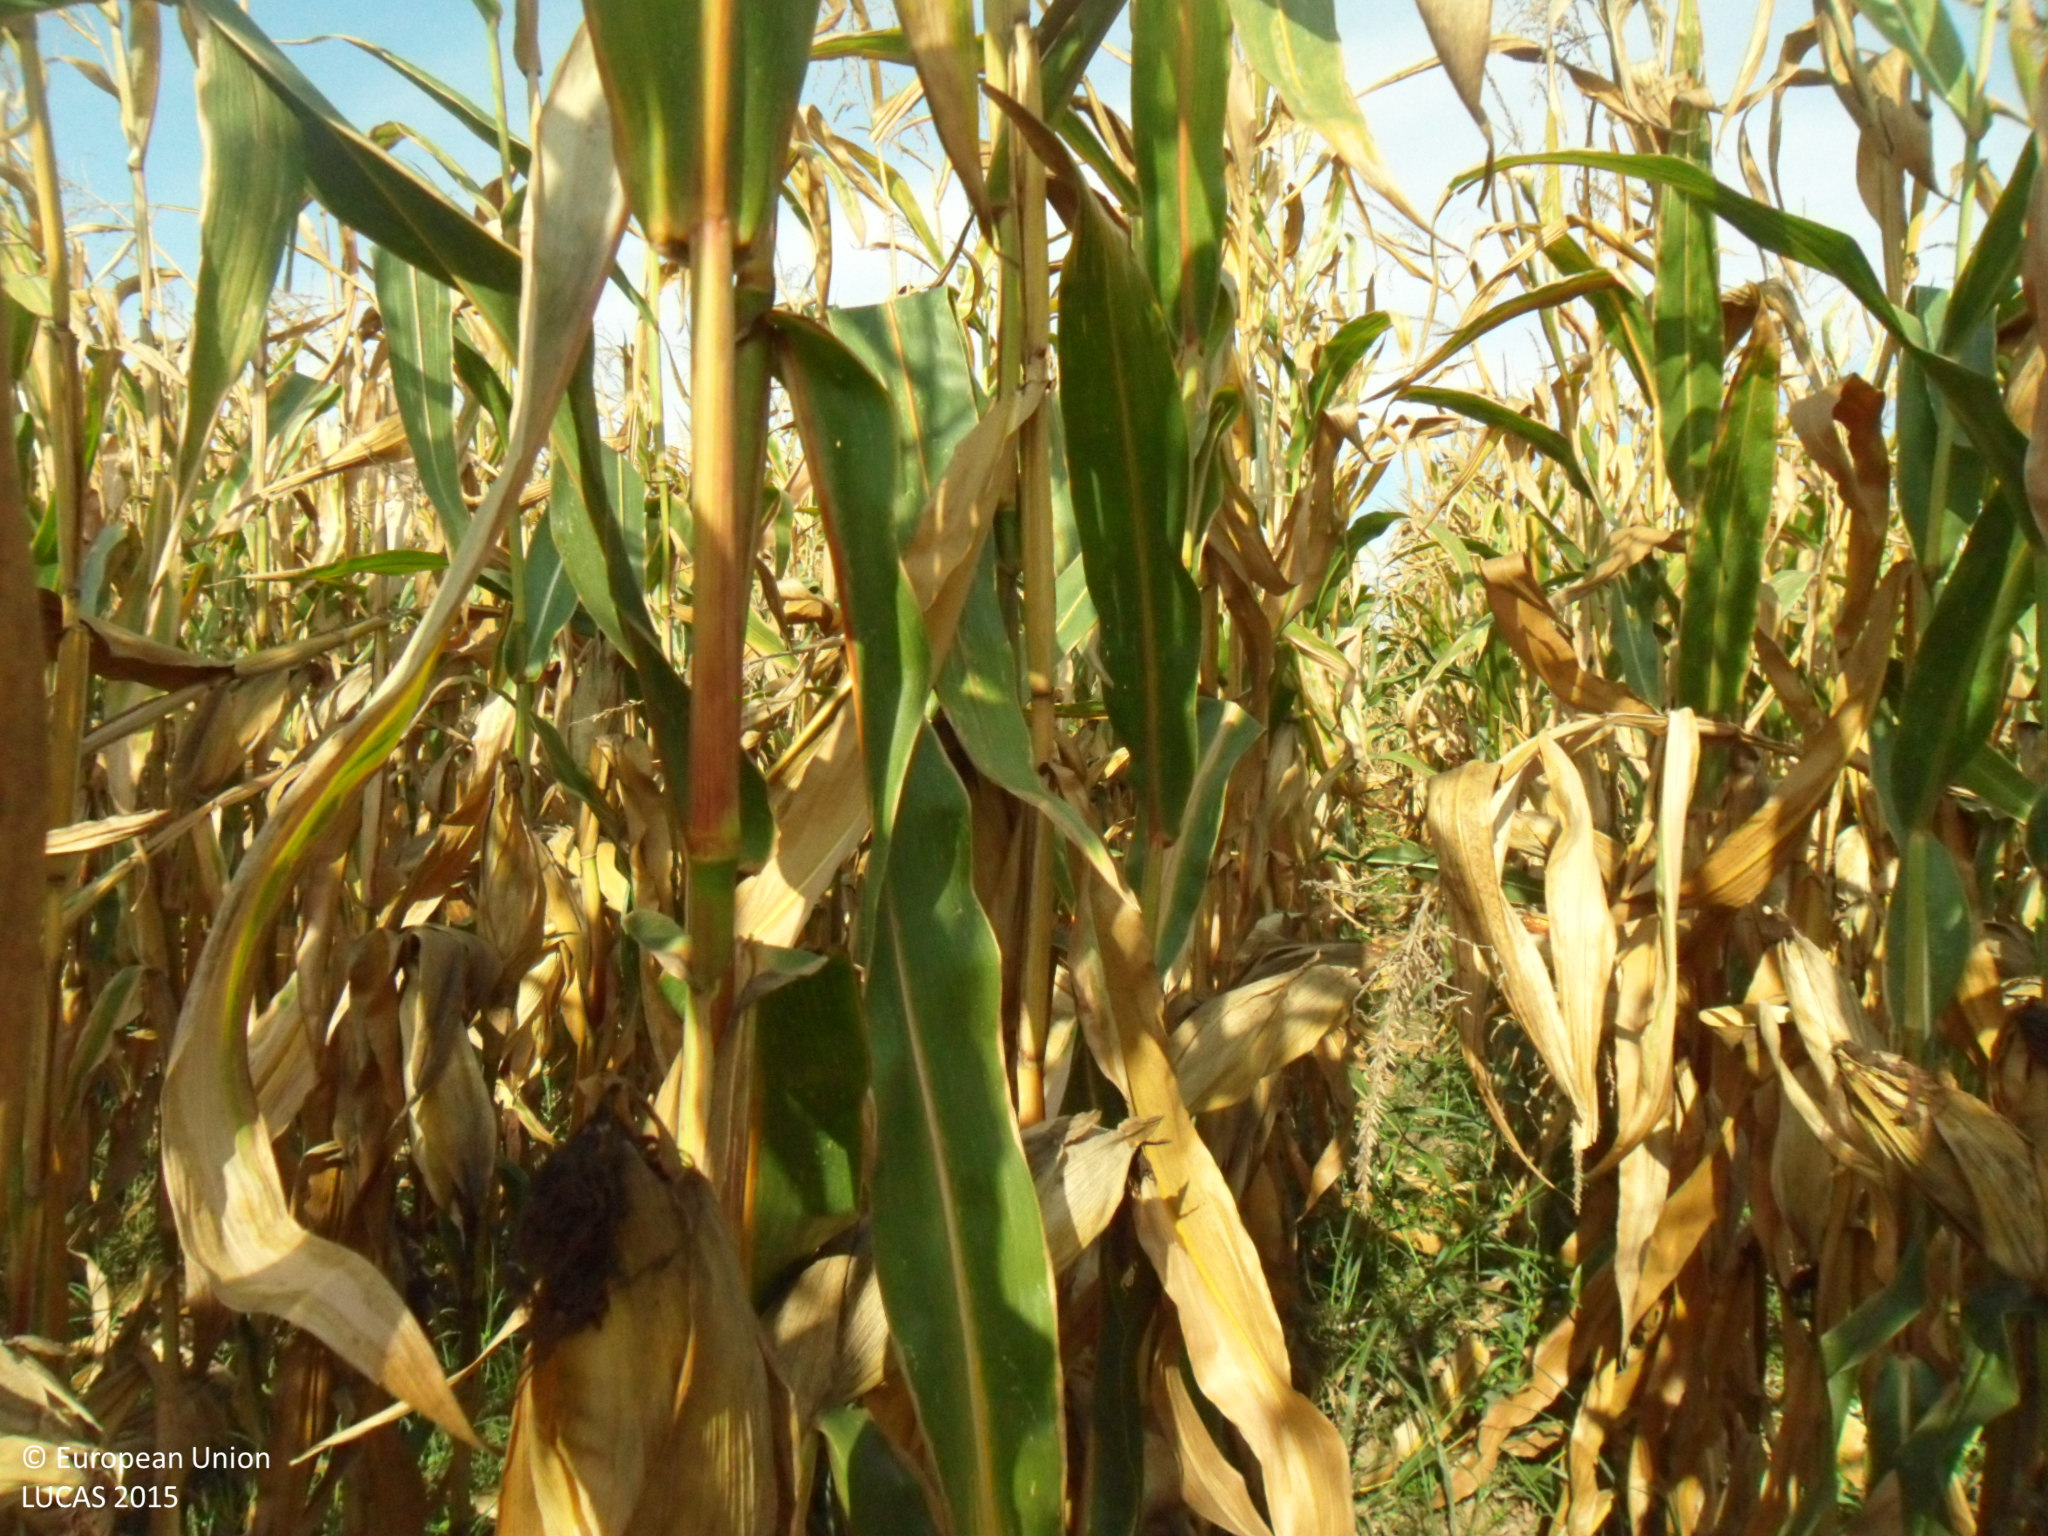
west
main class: Cropland
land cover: Maize
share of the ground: > 75 %
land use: Agriculture (excluding fallow land and kitchen gardens)
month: September
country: BG
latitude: 43.6152
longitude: 26.2199
